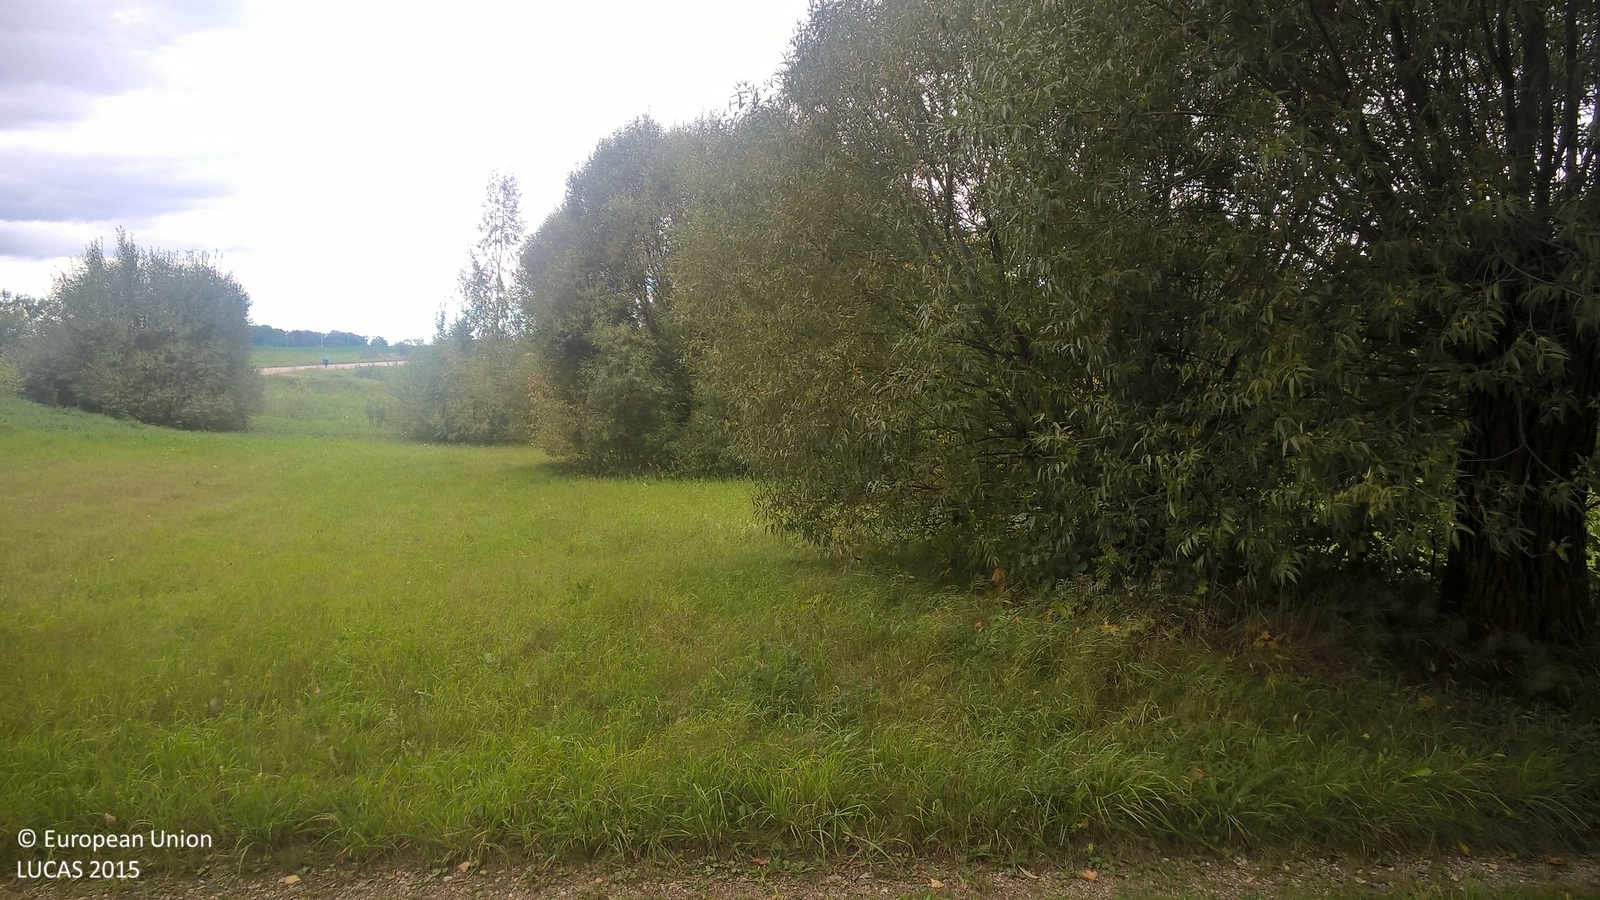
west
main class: Woodland
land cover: Broadleaved woodland
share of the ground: 10 - 25 %
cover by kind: herbaceous plants 70 %, broadleaved forest trees 20 %, shrubs 5 %, lichens and mosses 5 %
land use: Forestry
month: September
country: LV
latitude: 57.4603
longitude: 25.9461
